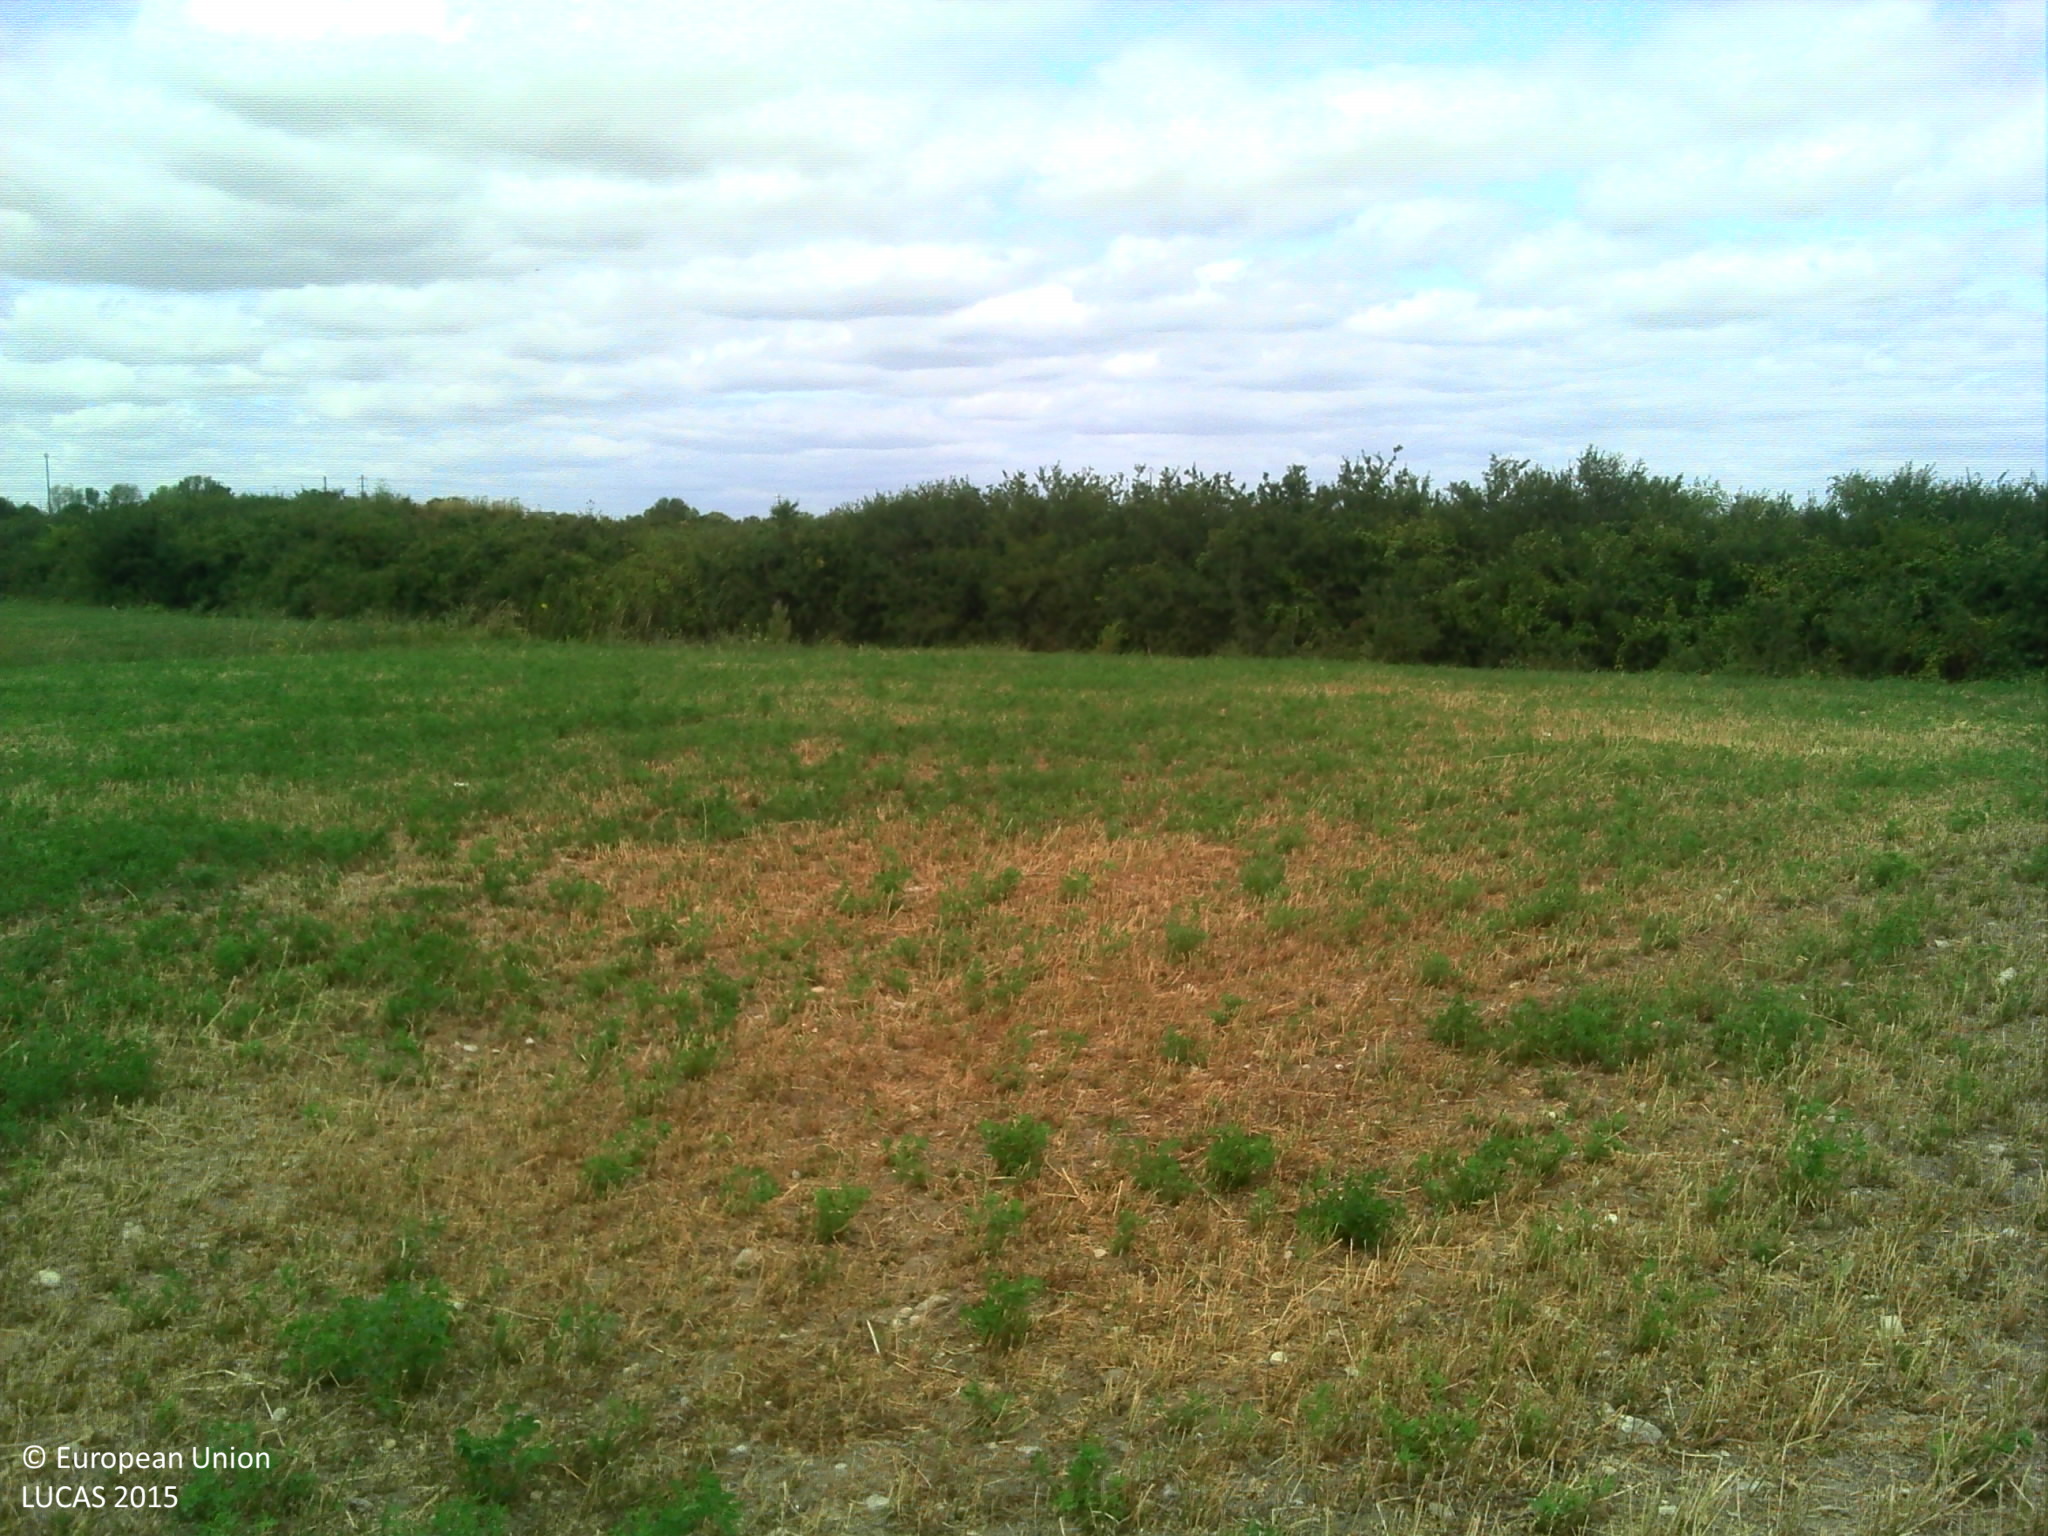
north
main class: Cropland
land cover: Lucerne
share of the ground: > 75 %
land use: Agriculture (excluding fallow land and kitchen gardens)
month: July
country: FR
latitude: 46.4035
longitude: -1.3123
